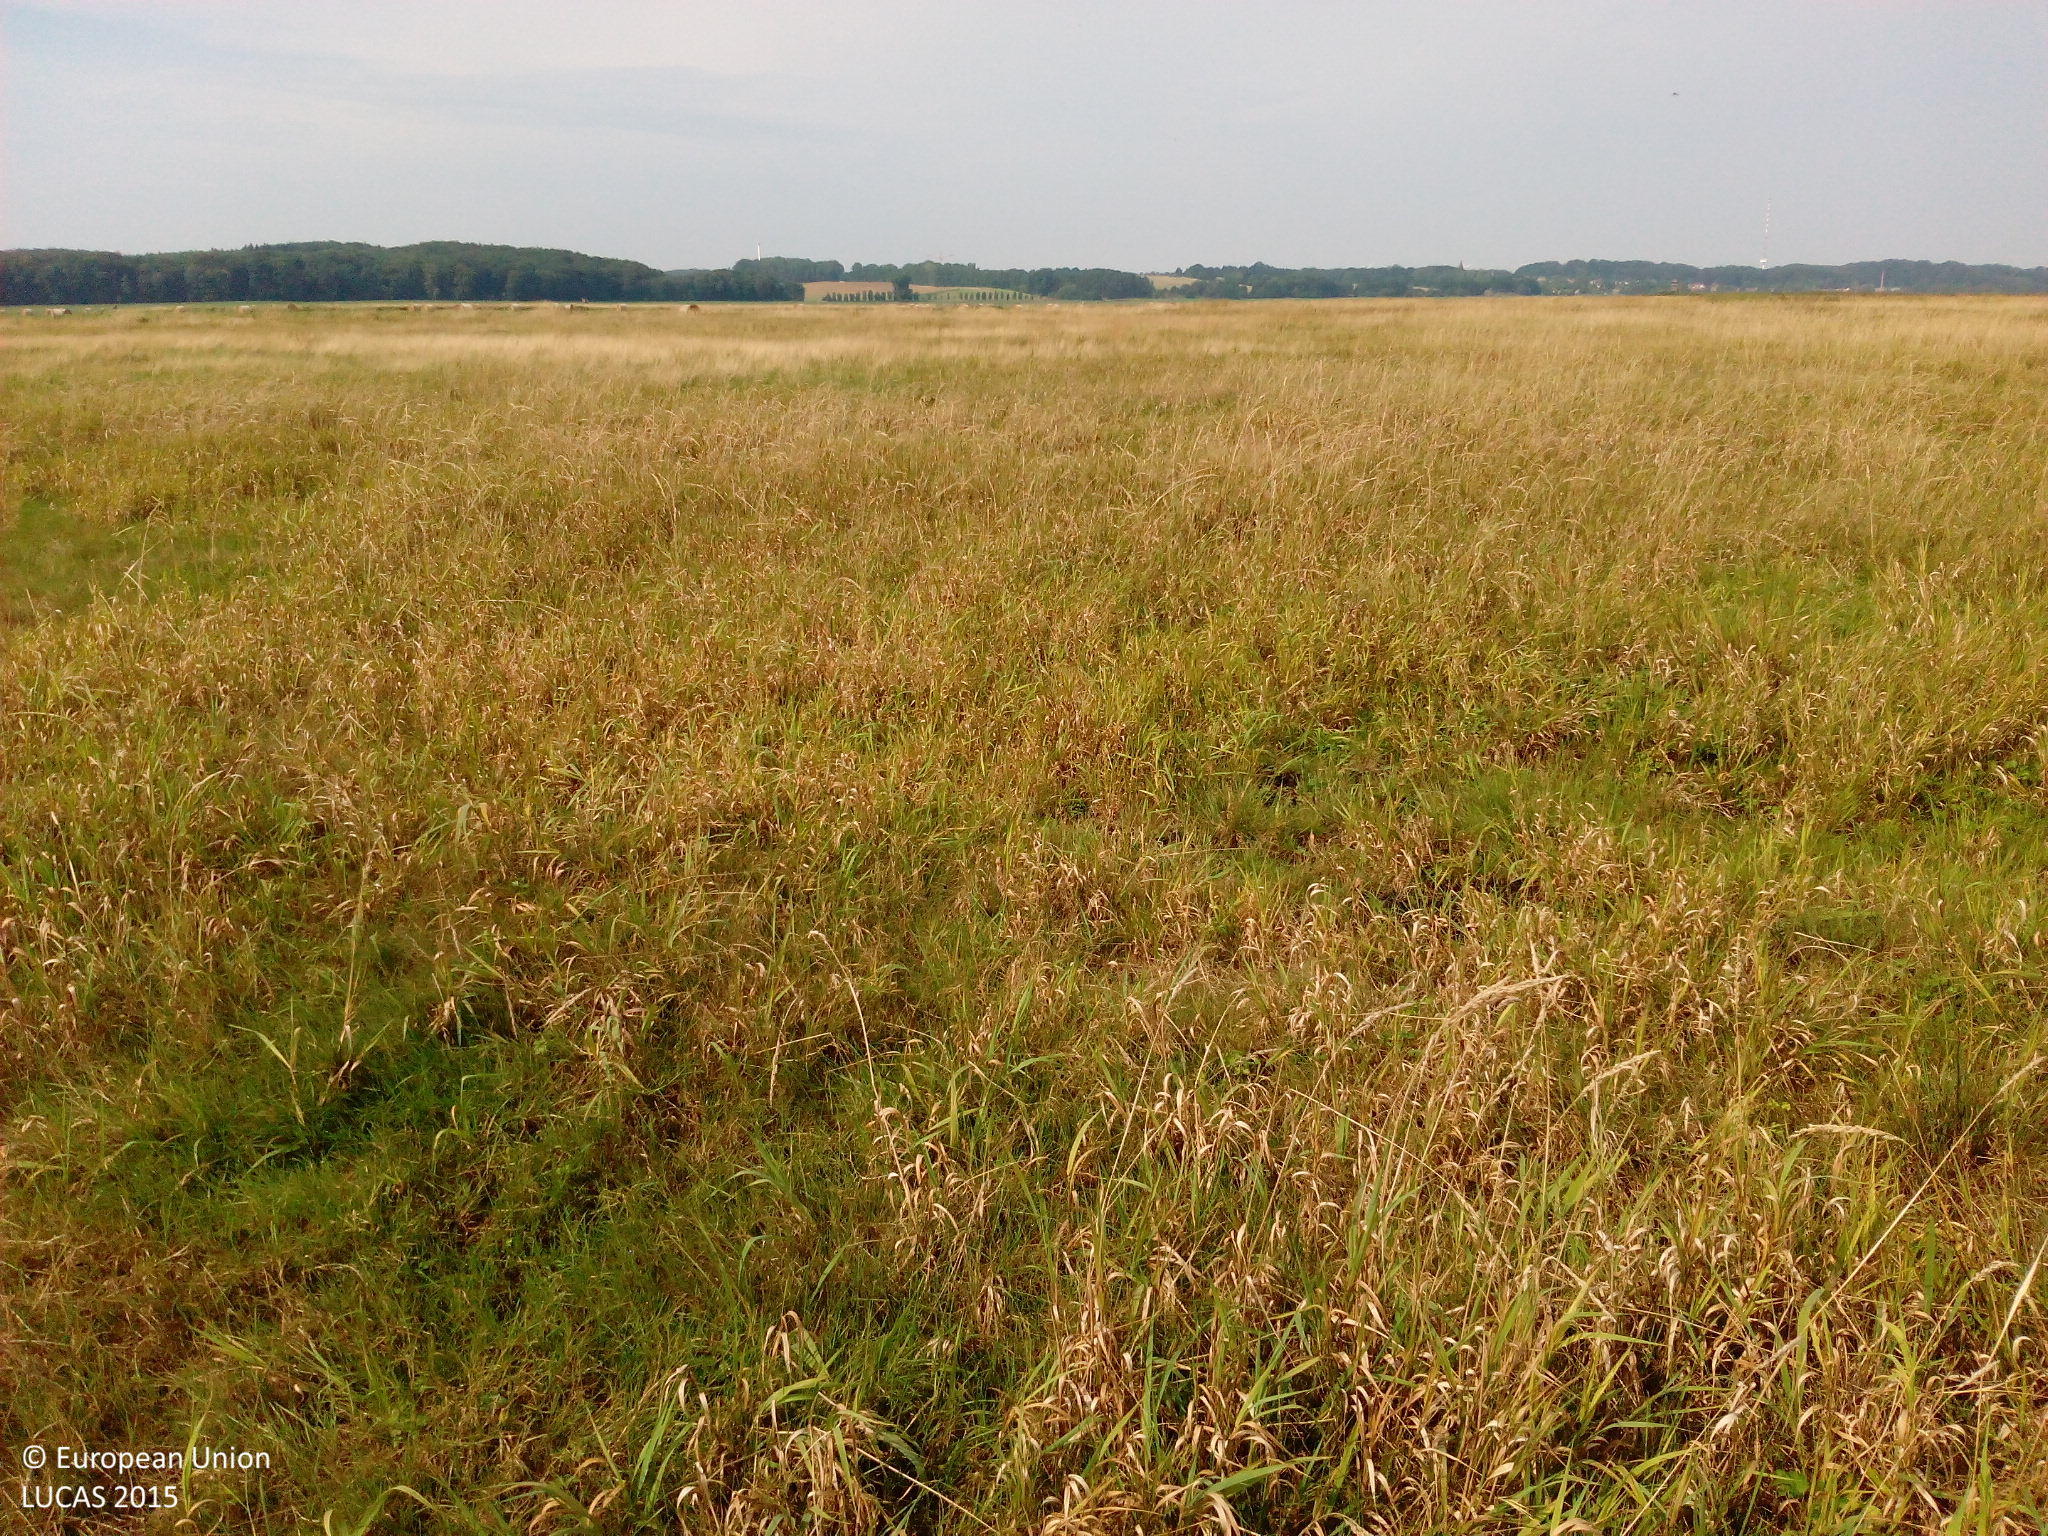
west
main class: Grassland
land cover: Grassland without tree/shrub cover
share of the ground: > 75 %
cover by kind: herbaceous plants 100 %
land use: Agriculture (excluding fallow land and kitchen gardens)
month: August
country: DE
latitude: 54.1469
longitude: 12.6170
